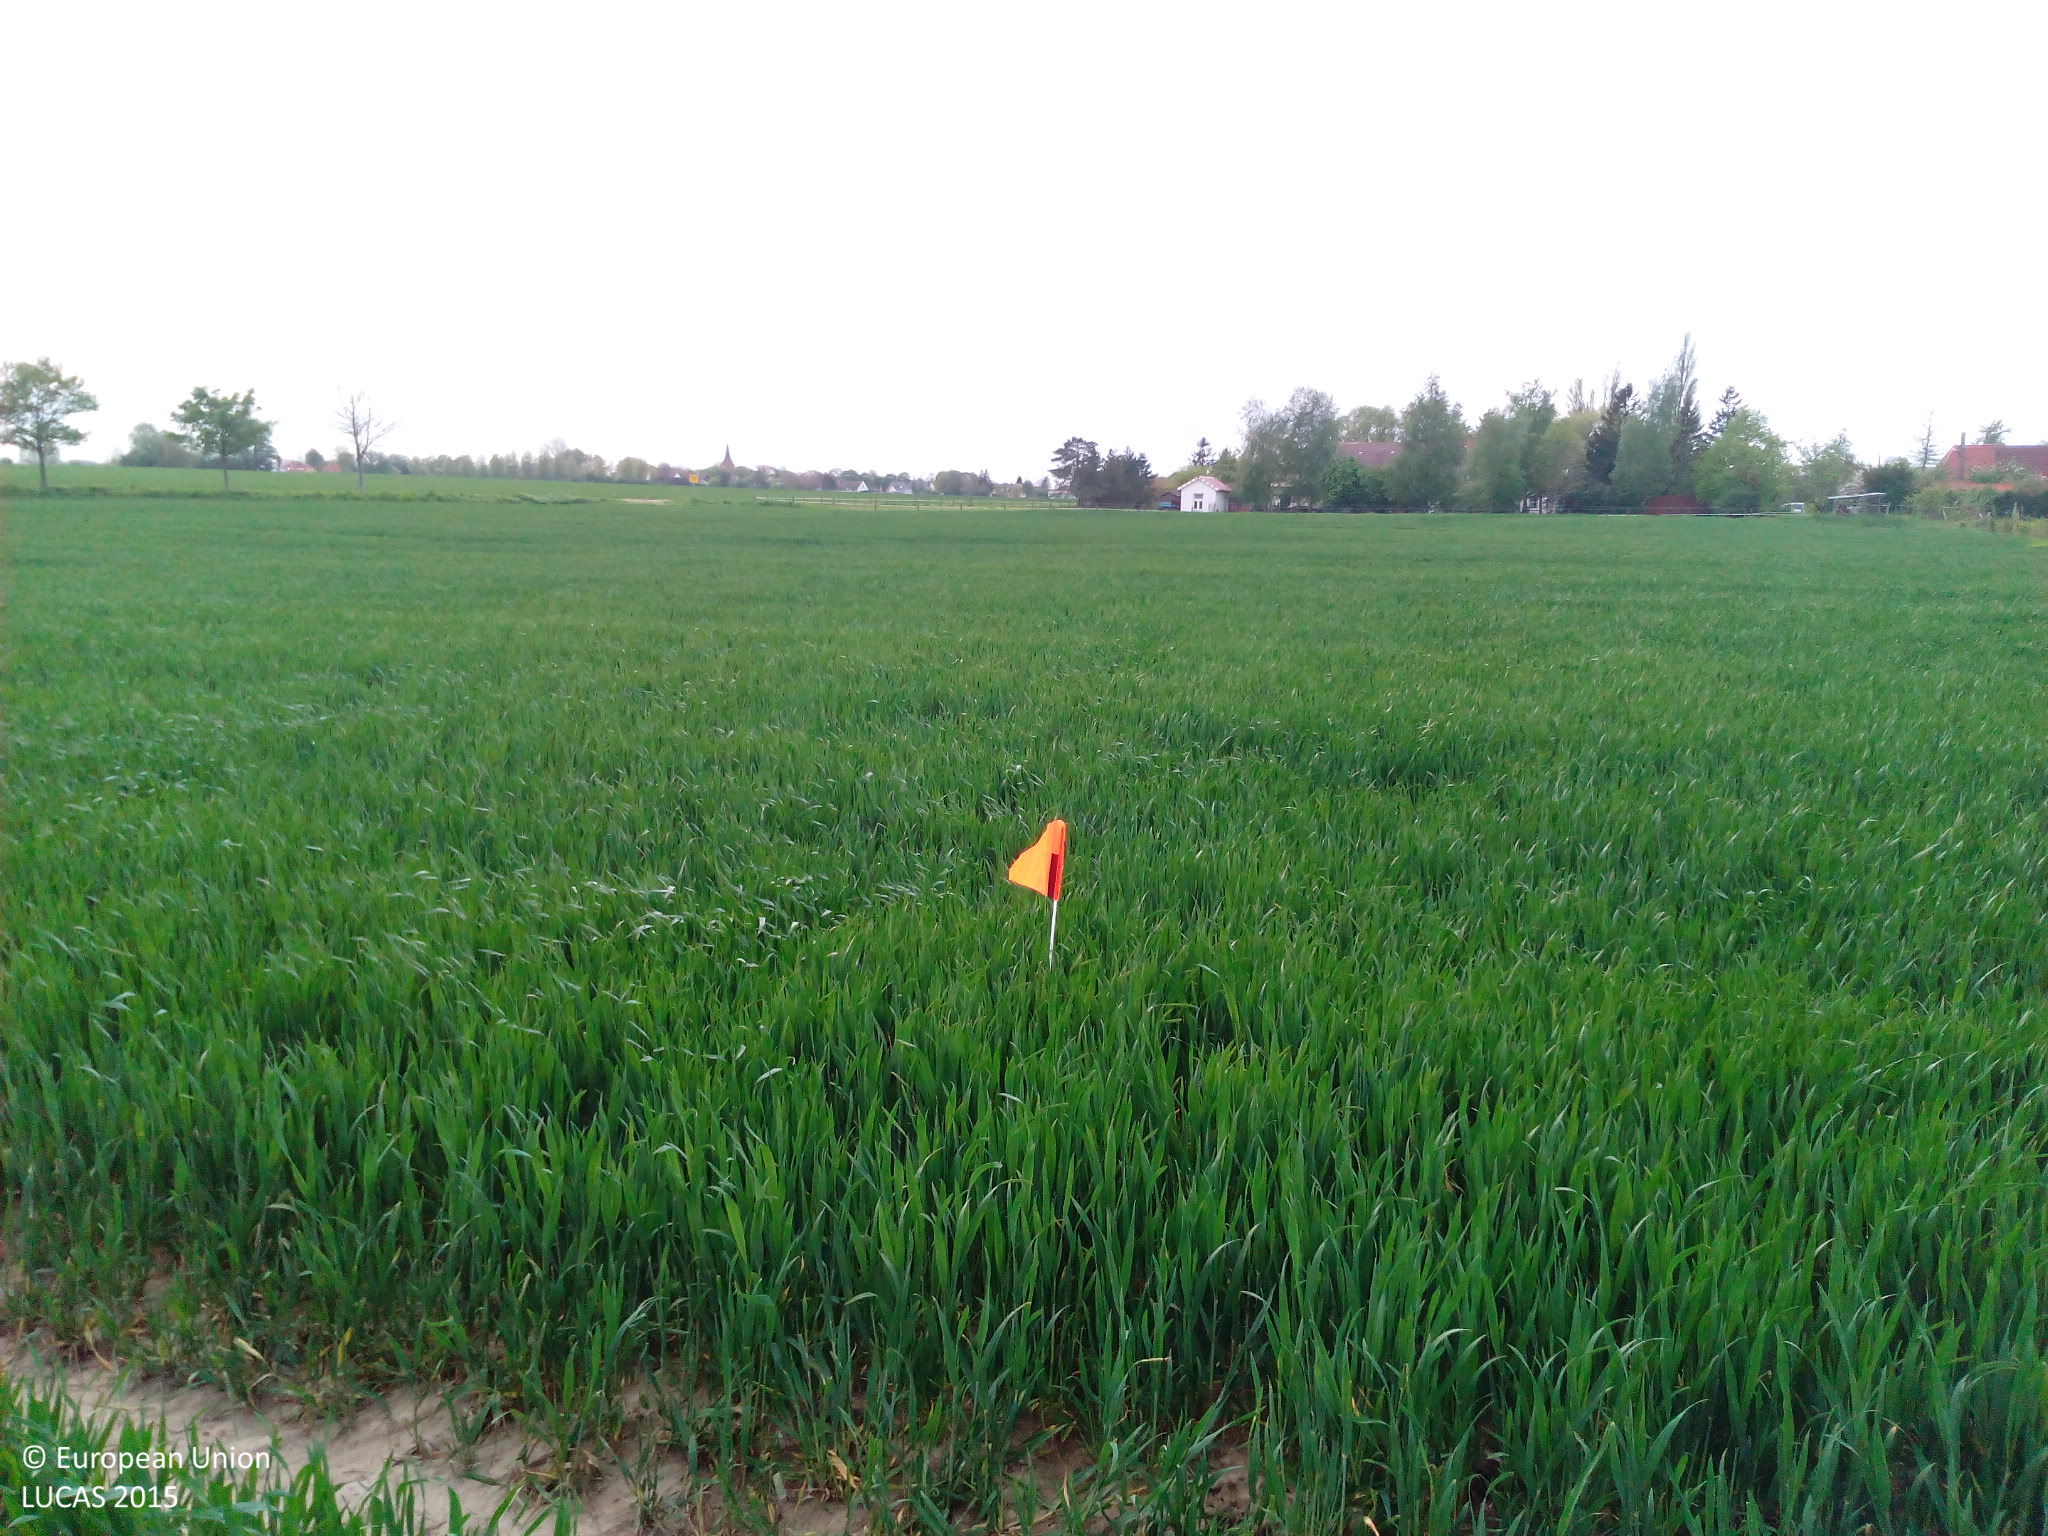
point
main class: Cropland
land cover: Common wheat
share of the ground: > 75 %
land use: Agriculture (excluding fallow land and kitchen gardens)
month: May
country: DE
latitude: 54.3085
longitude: 12.6272
